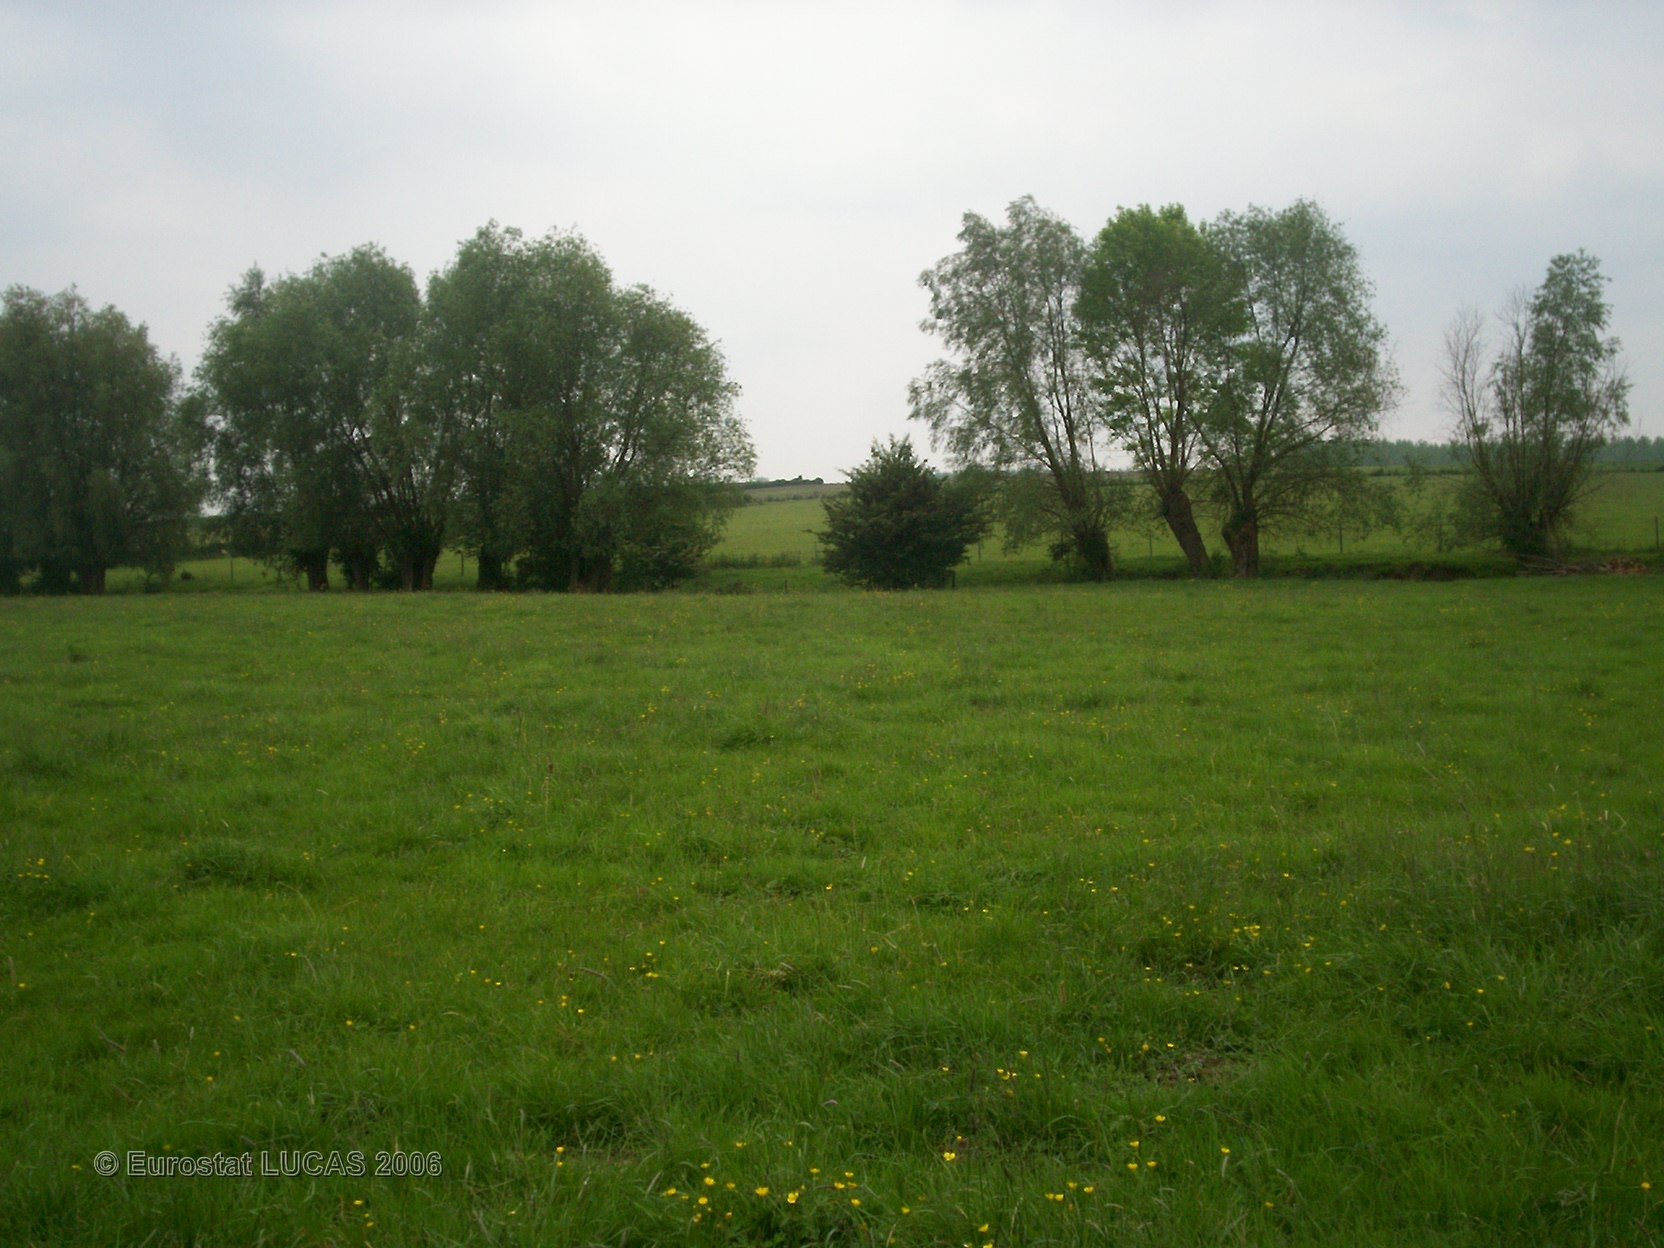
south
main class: Grassland
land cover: Grassland without tree/shrub cover
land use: Agriculture (excluding fallow land and kitchen gardens)
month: June
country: FR
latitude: 50.3160
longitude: 3.6875
